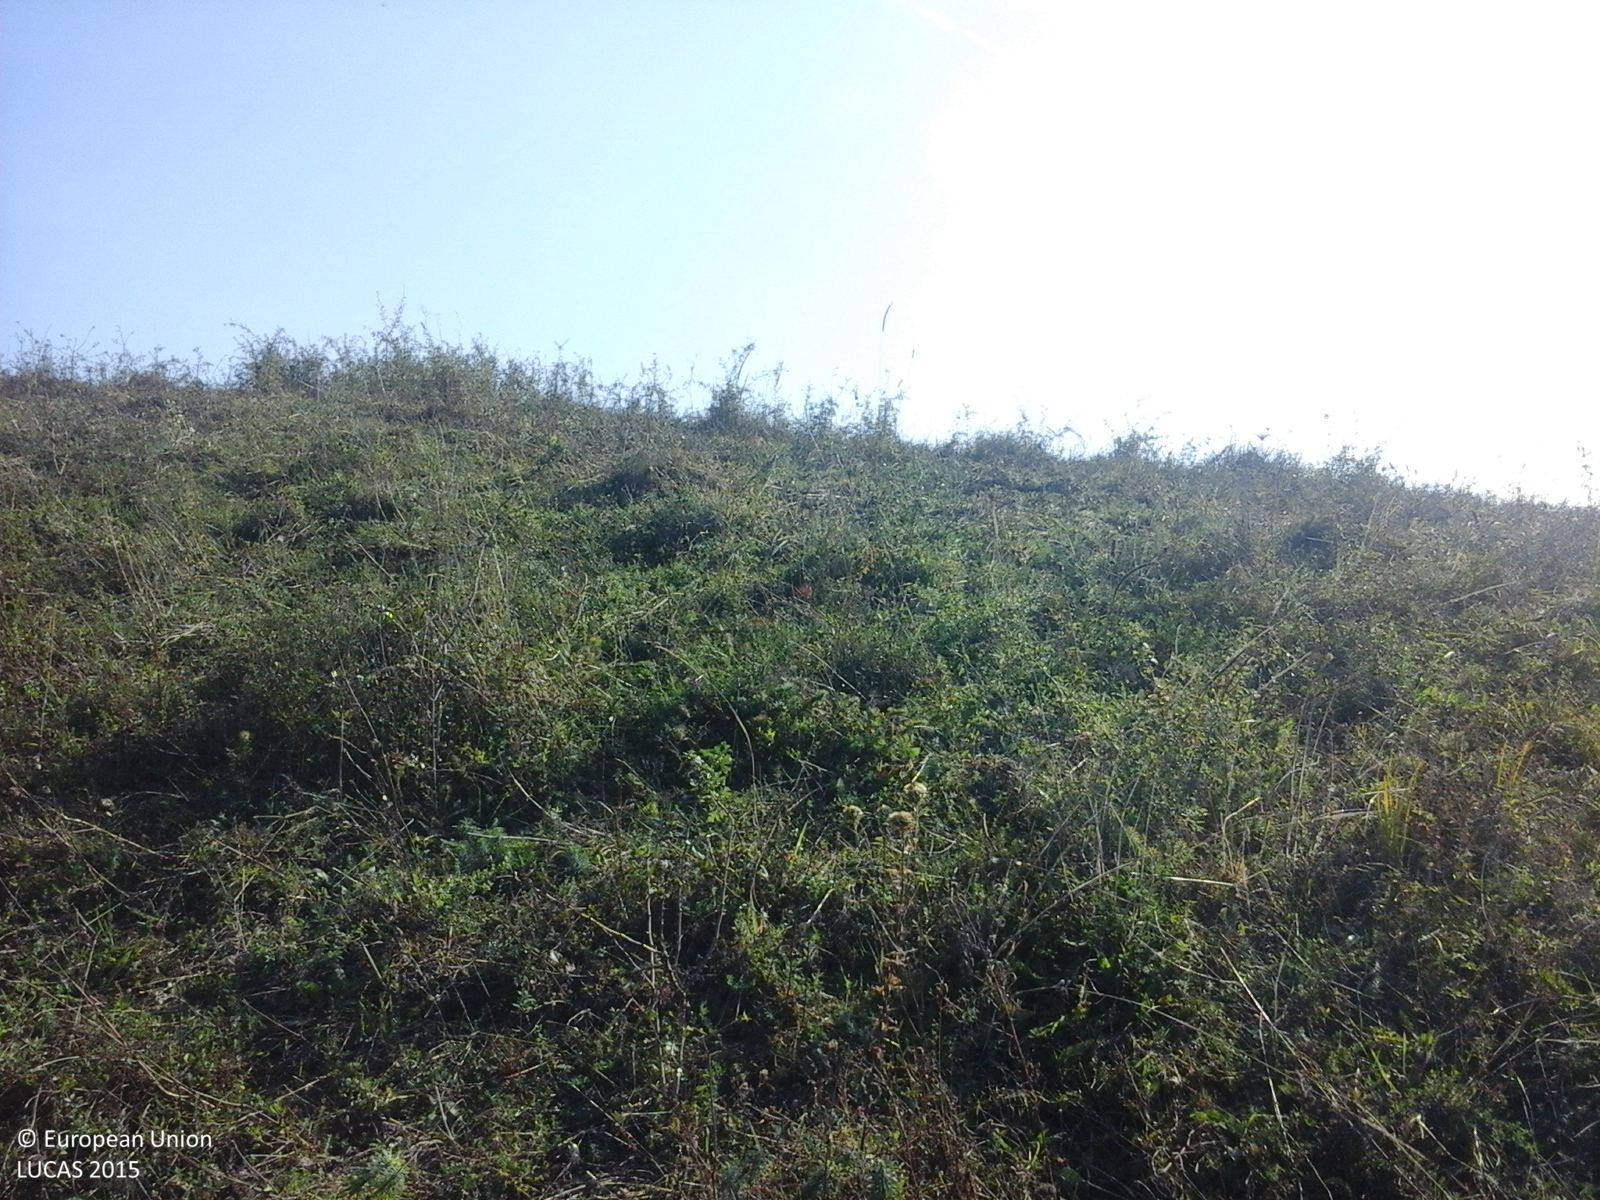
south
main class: Grassland
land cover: Spontaneously vegetated surfaces
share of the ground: > 75 %
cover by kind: herbaceous plants 100 %
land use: Fallow land
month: September
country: RO
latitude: 47.3420
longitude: 23.7229
